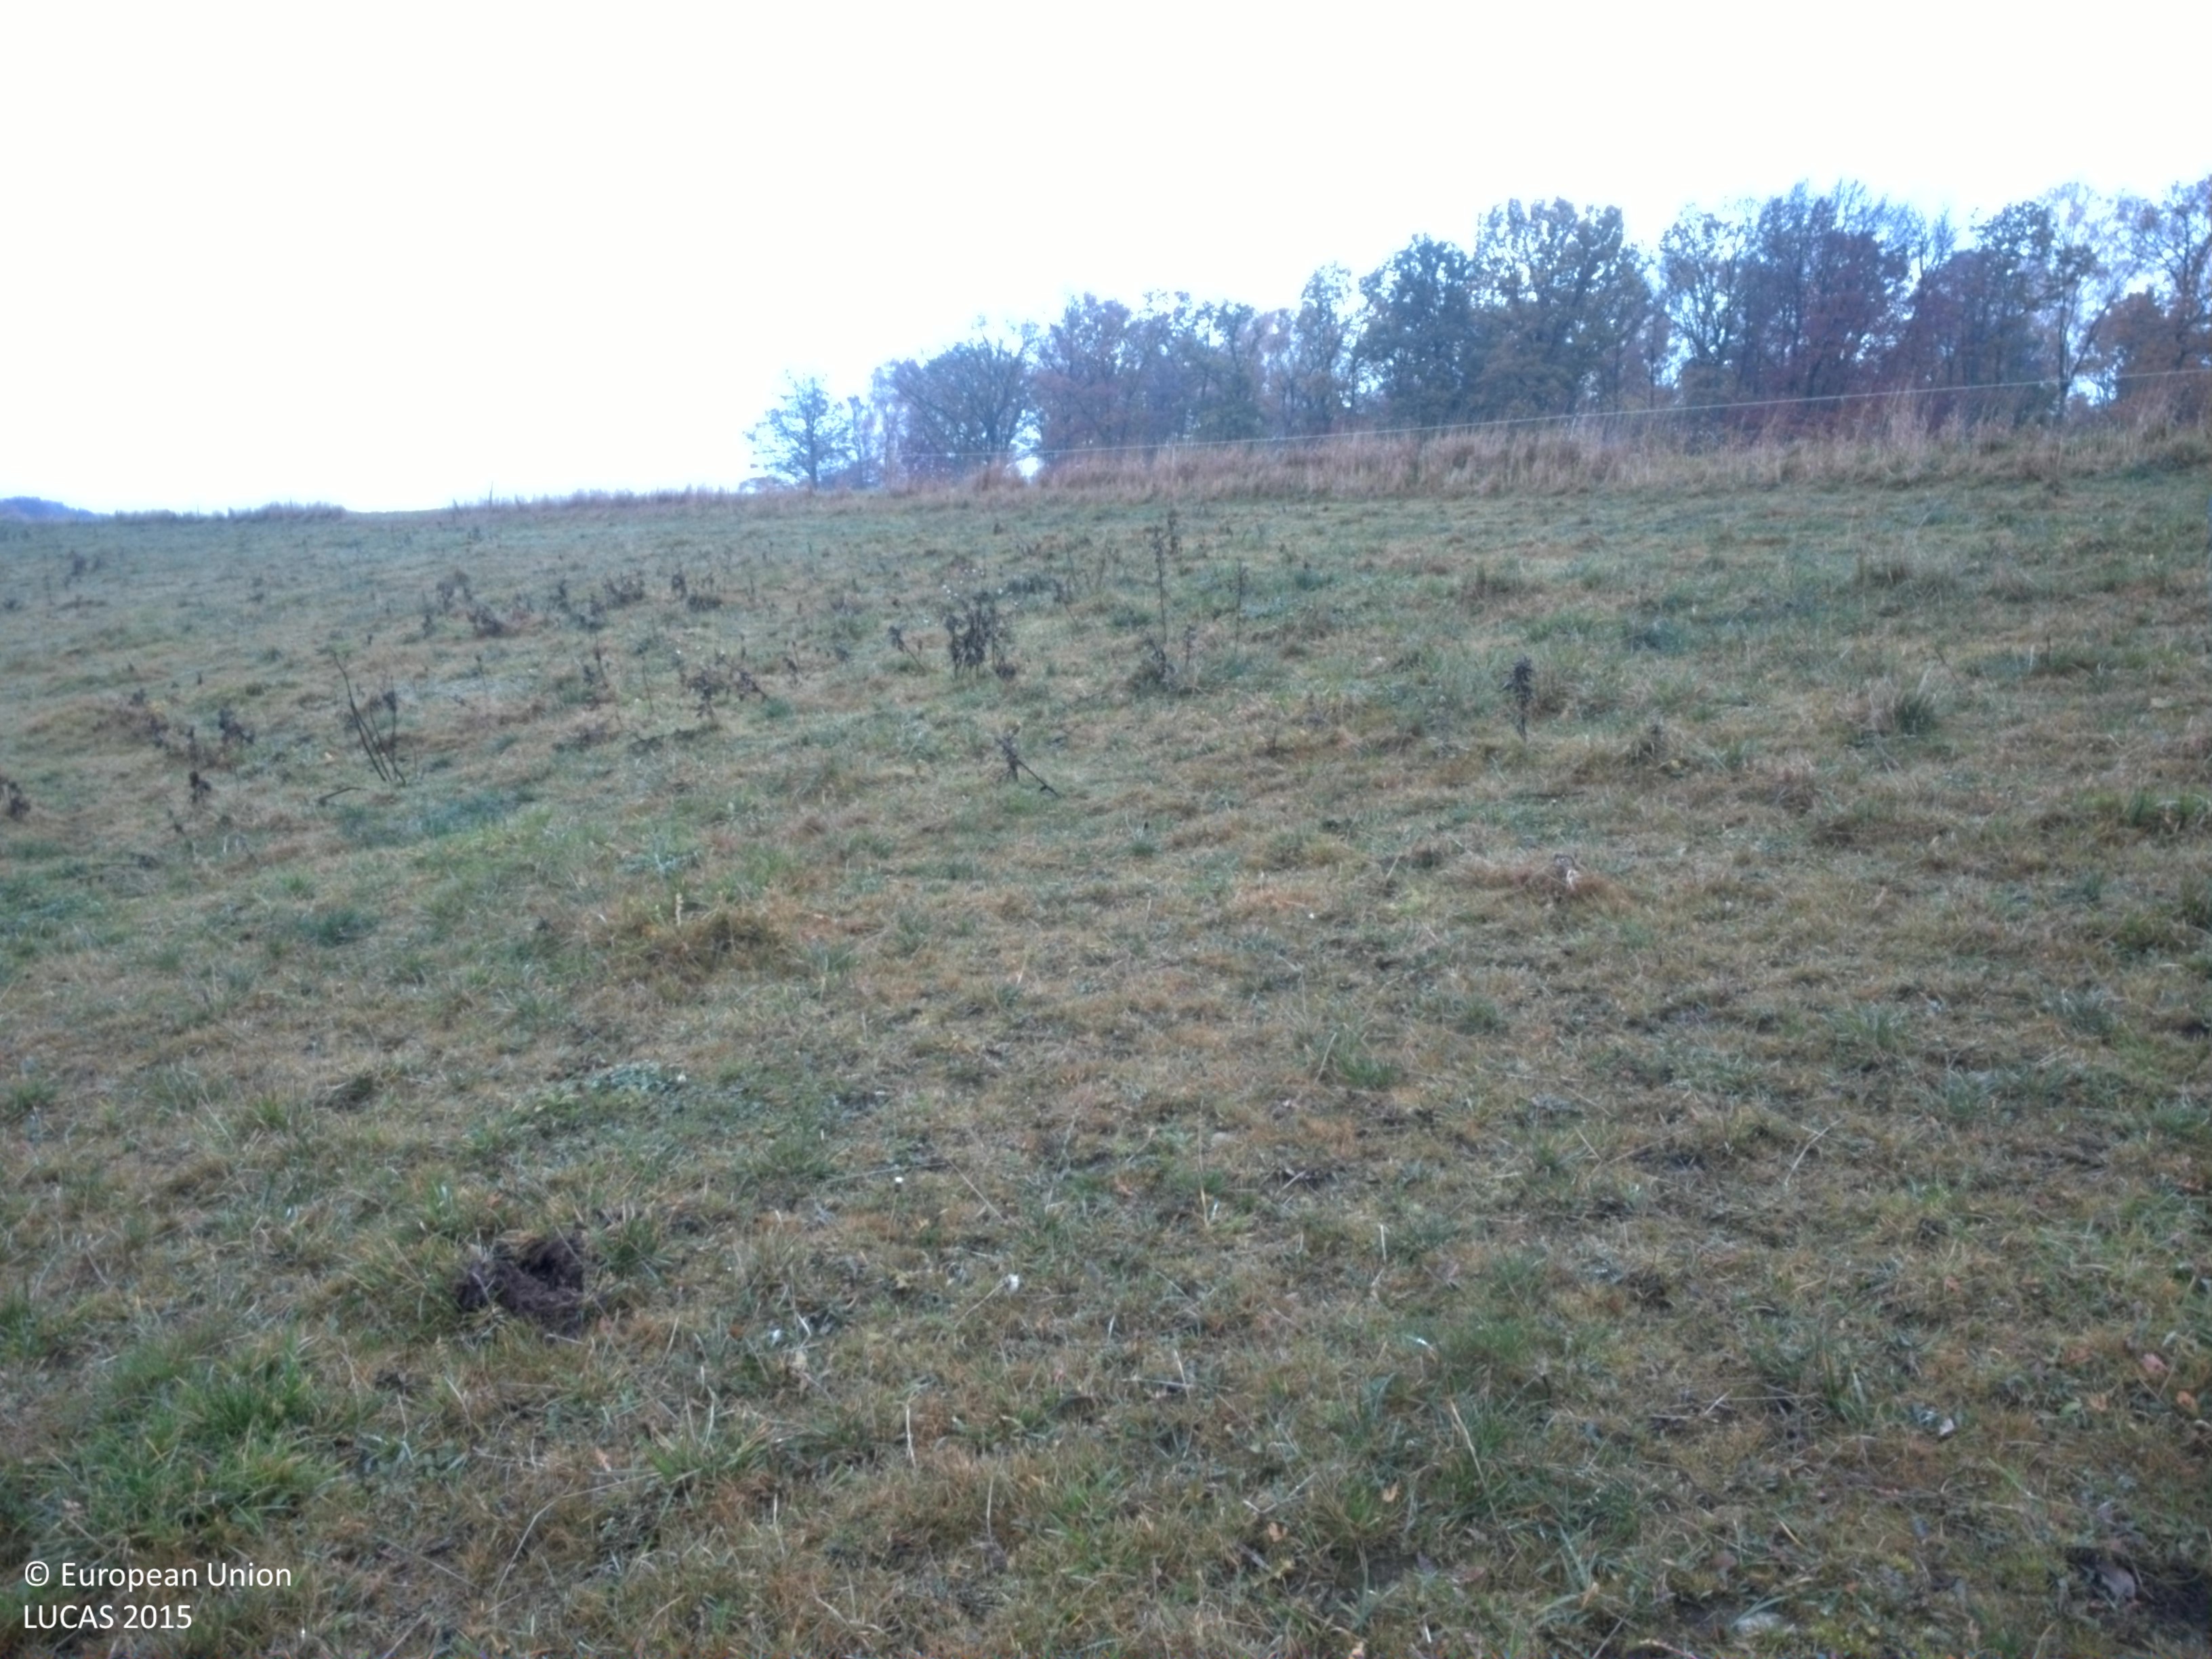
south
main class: Grassland
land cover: Grassland without tree/shrub cover
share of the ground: > 75 %
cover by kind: herbaceous plants 100 %
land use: Agriculture (excluding fallow land and kitchen gardens)
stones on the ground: < 10 %
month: November
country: SE
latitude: 56.0433
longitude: 13.0636
